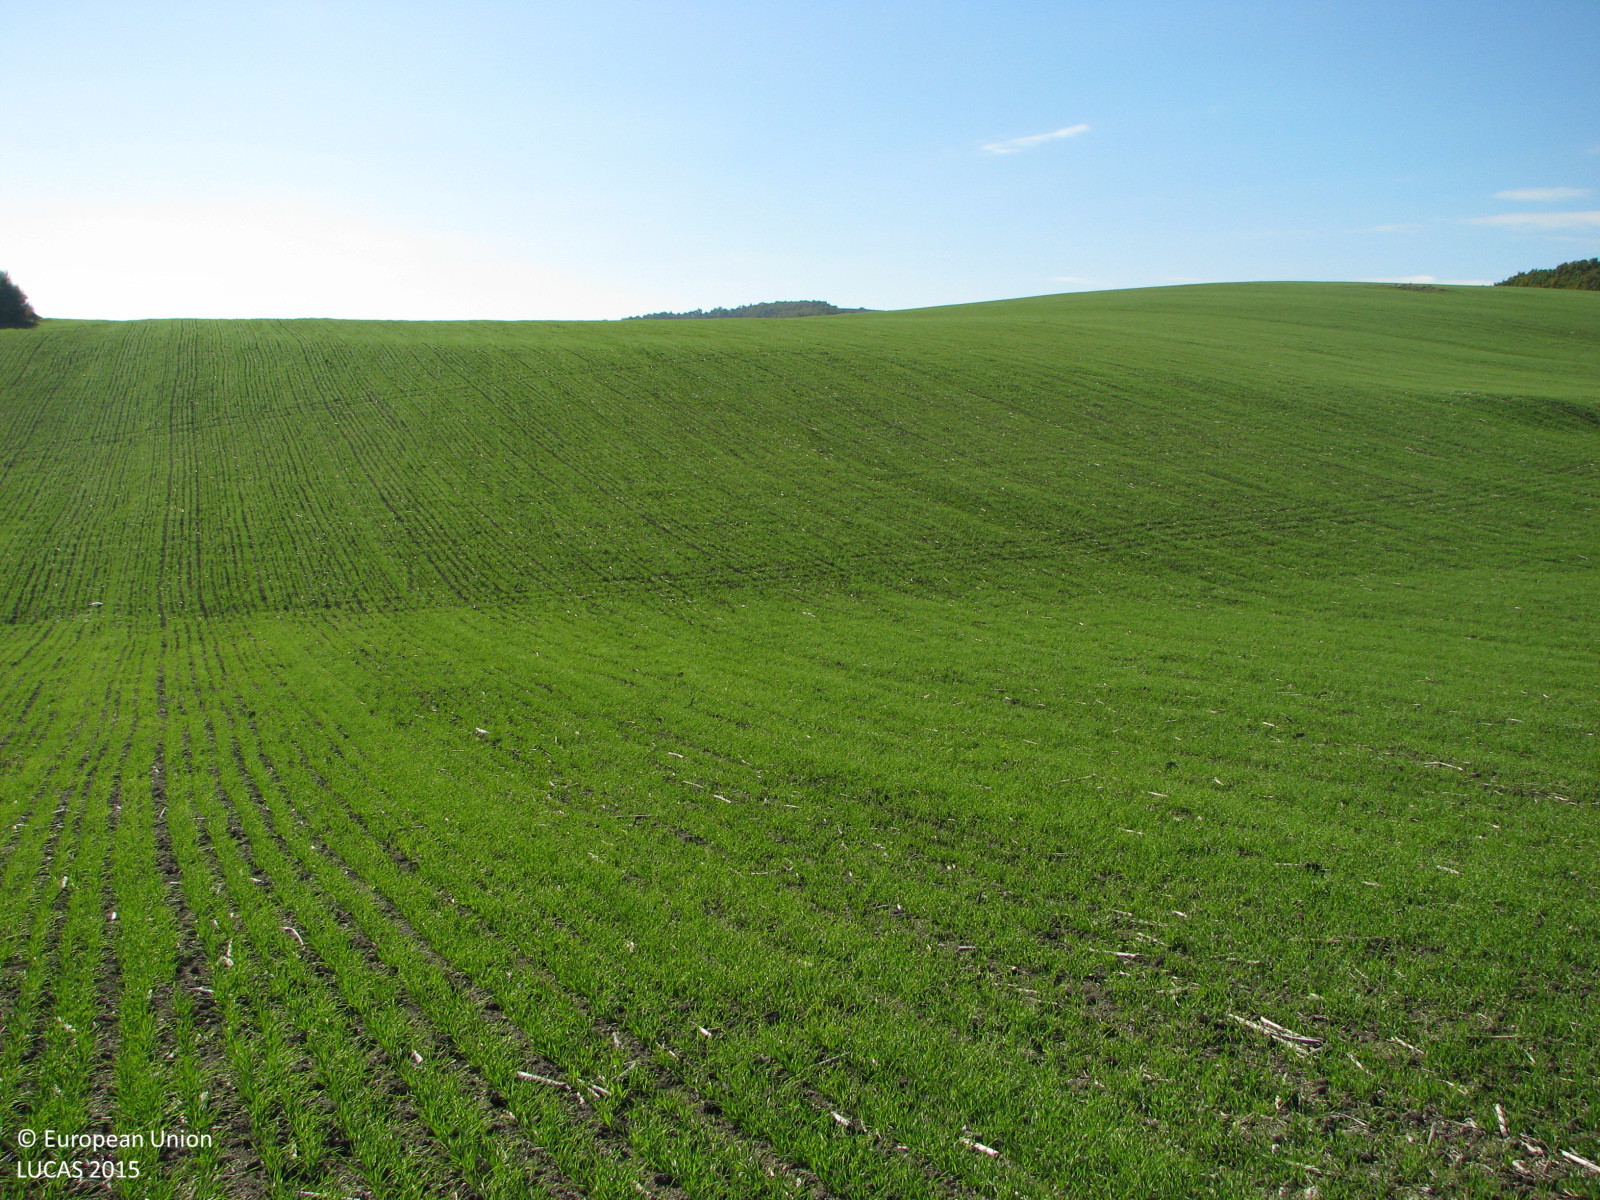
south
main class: Cropland
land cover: Common wheat
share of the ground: 50 - 75 %
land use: Agriculture (excluding fallow land and kitchen gardens)
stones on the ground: < 10 %
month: November
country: BG
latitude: 42.1566
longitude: 26.4864
